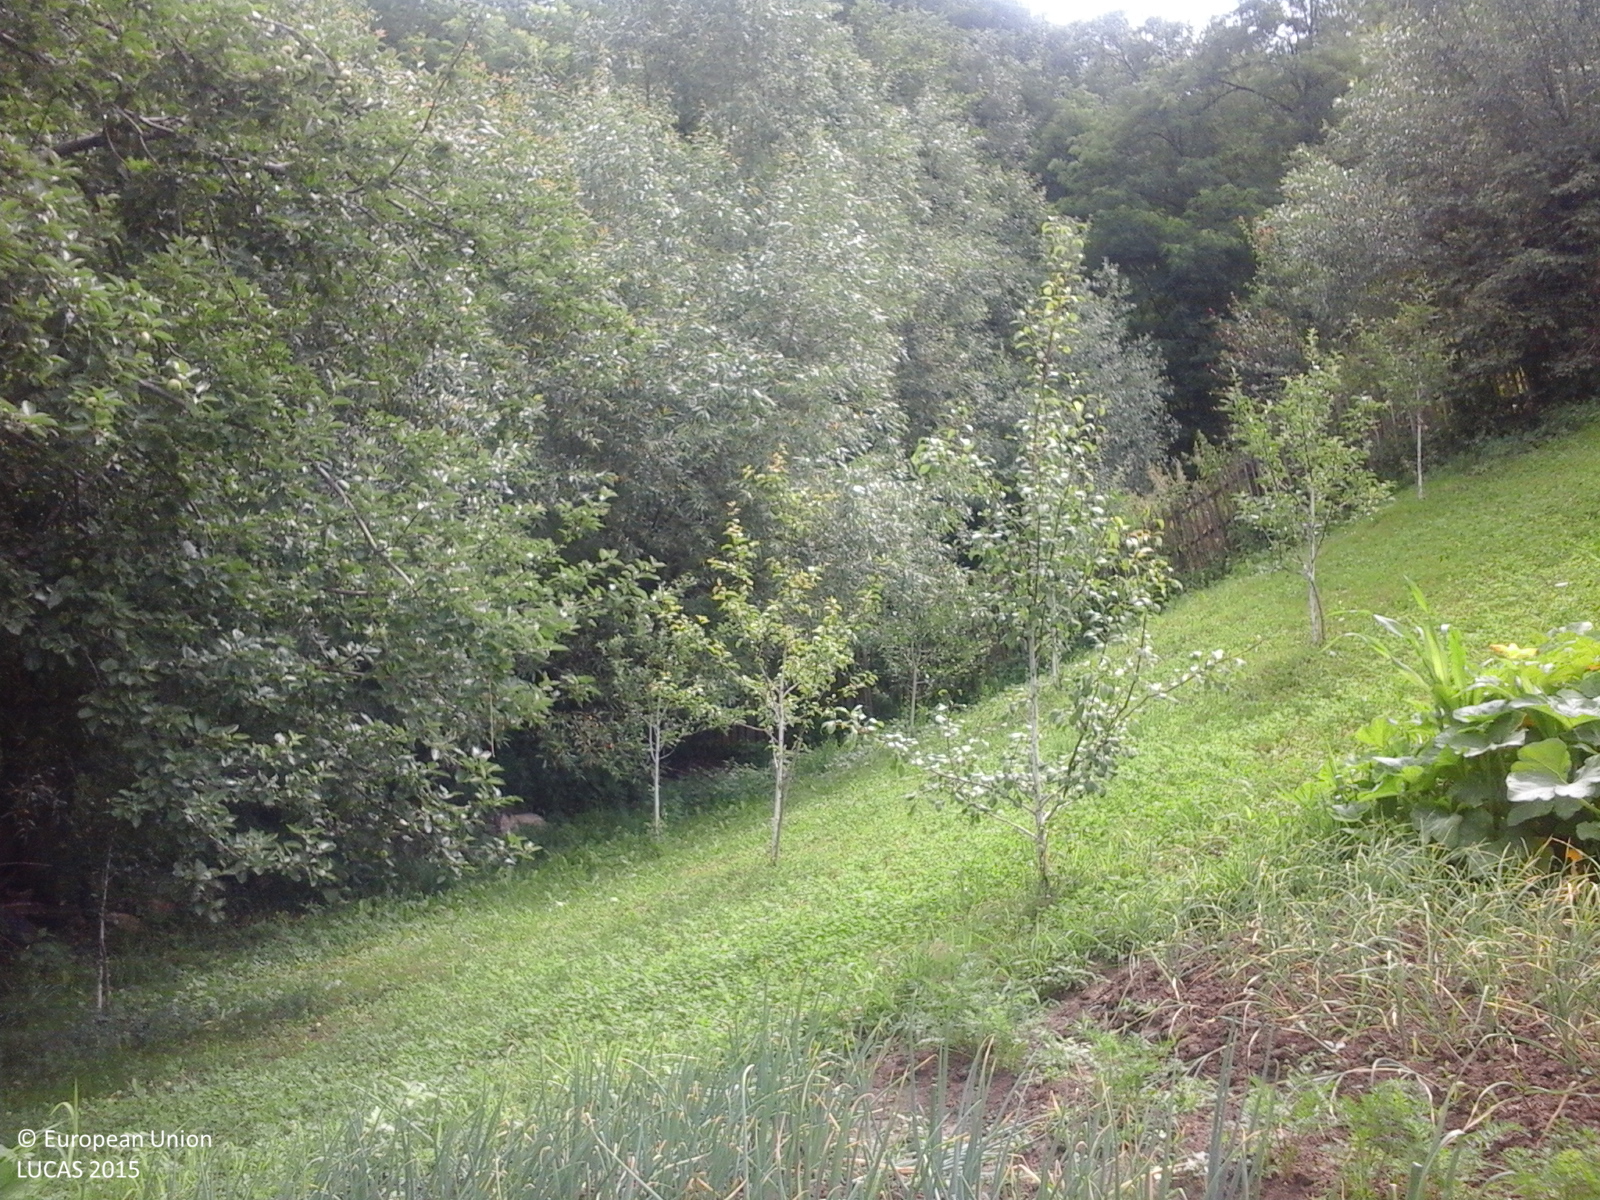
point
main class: Cropland
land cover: Apple fruit
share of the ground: > 75 %
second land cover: Grassland without tree/shrub cover
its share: > 75 %
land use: Agriculture (excluding fallow land and kitchen gardens)
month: July
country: RO
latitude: 45.1995
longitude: 24.7081
